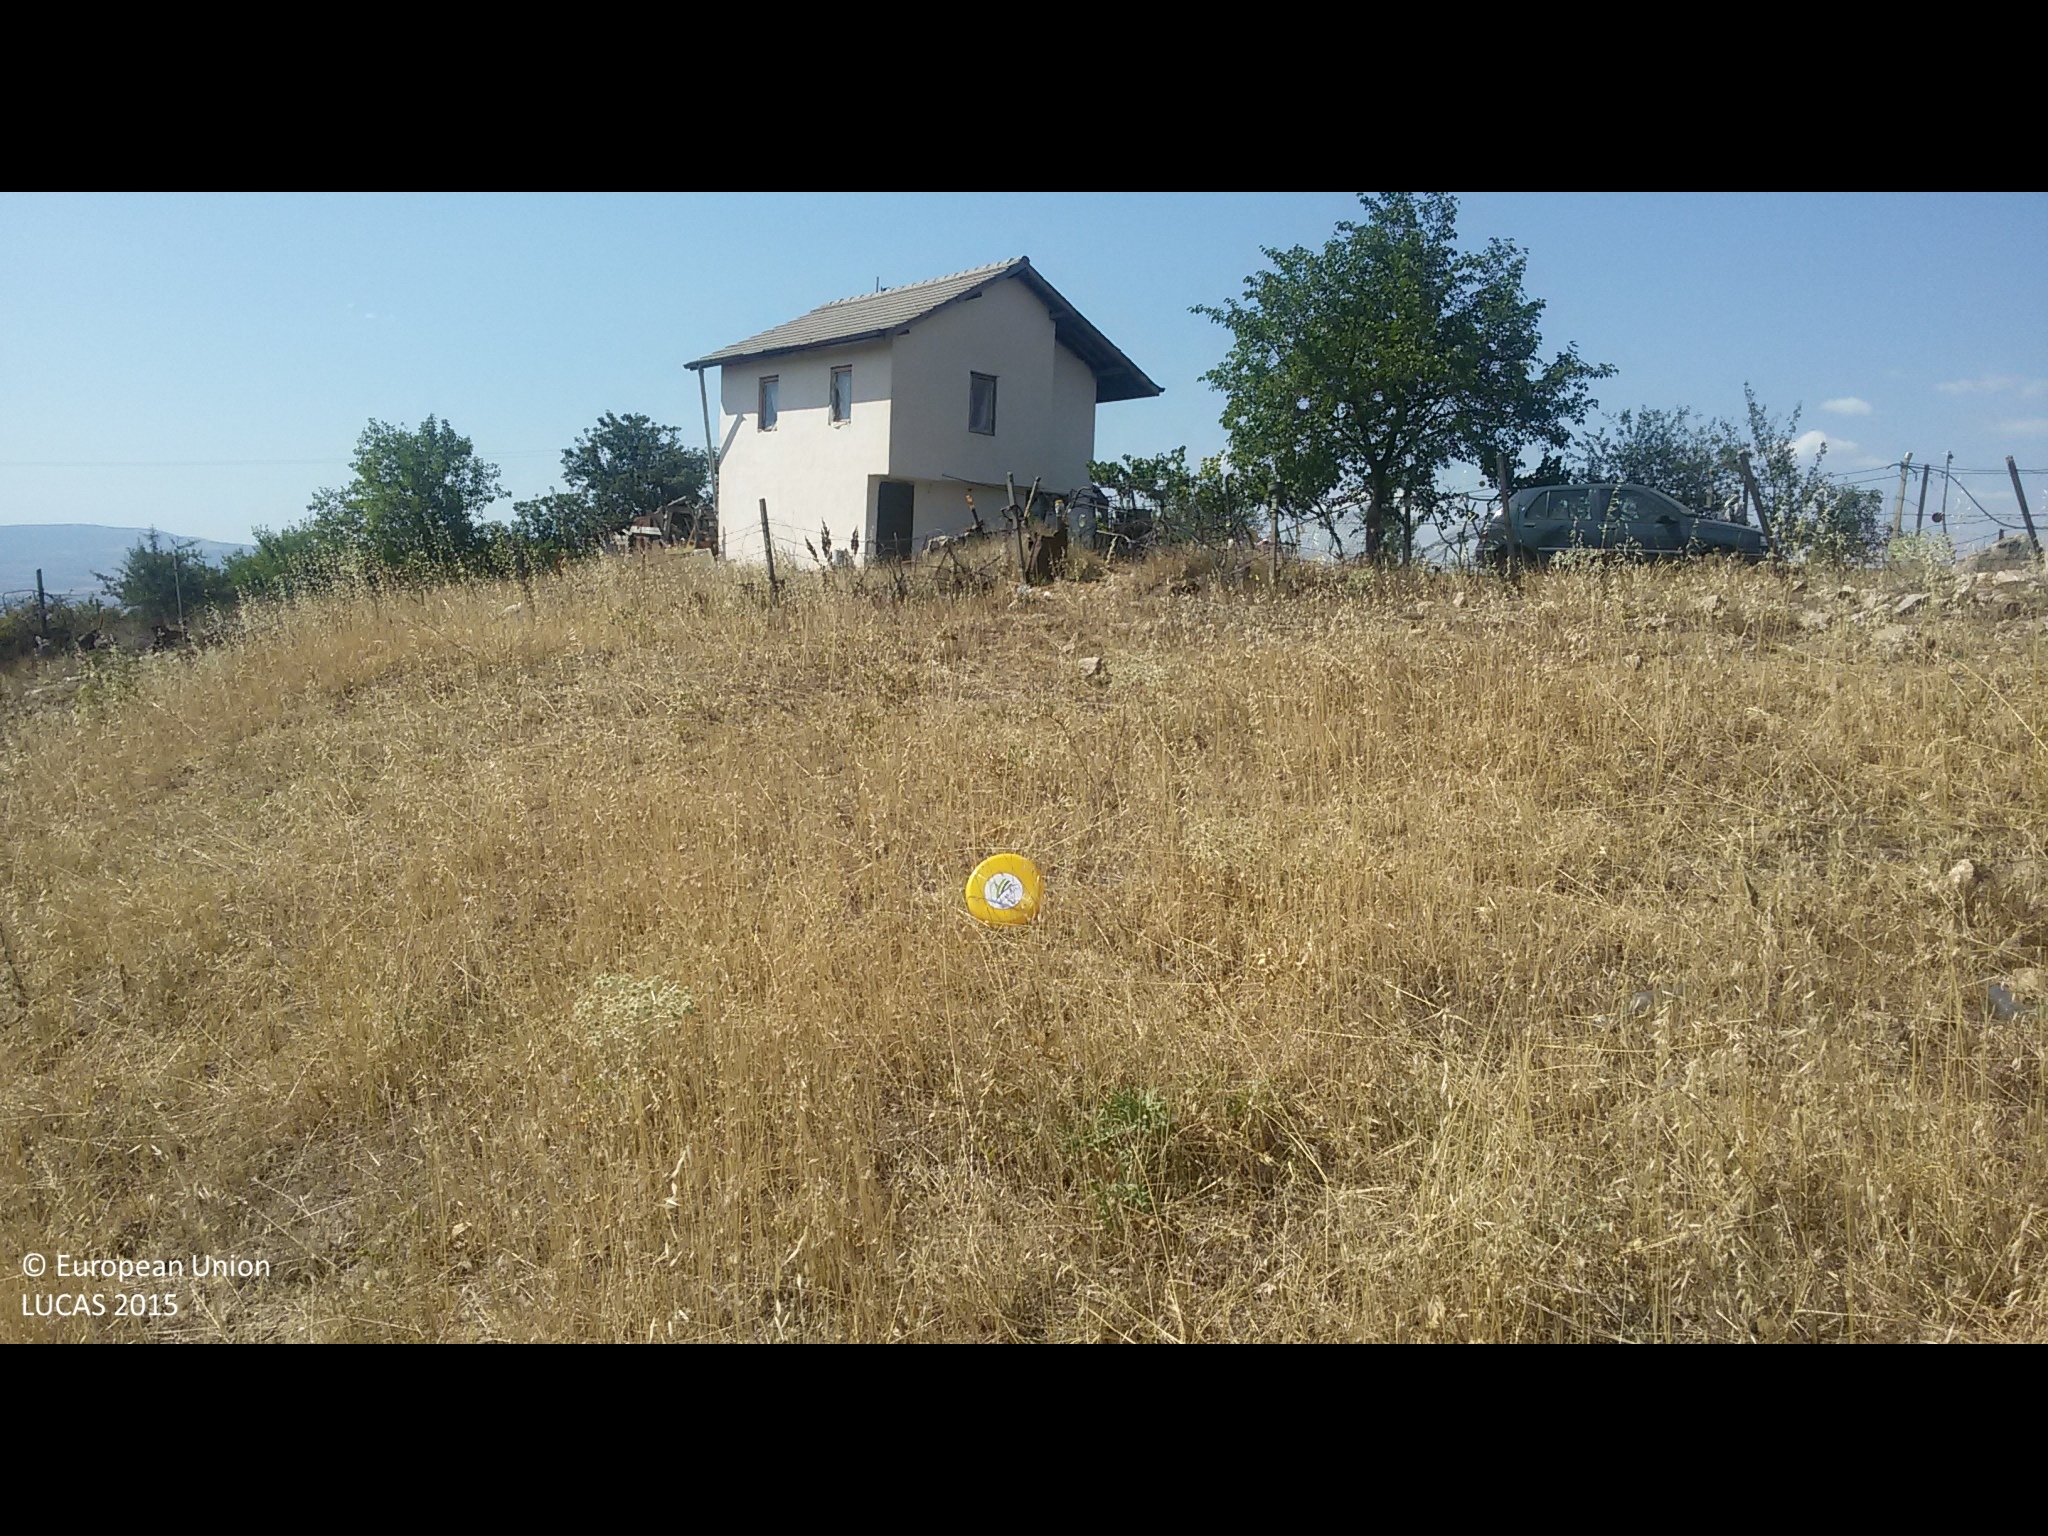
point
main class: Grassland
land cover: Grassland without tree/shrub cover
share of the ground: > 75 %
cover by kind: herbaceous plants 95 %, shrubs 5 %
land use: Agriculture (excluding fallow land and kitchen gardens)
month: August
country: BG
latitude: 41.9972
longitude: 23.1228
